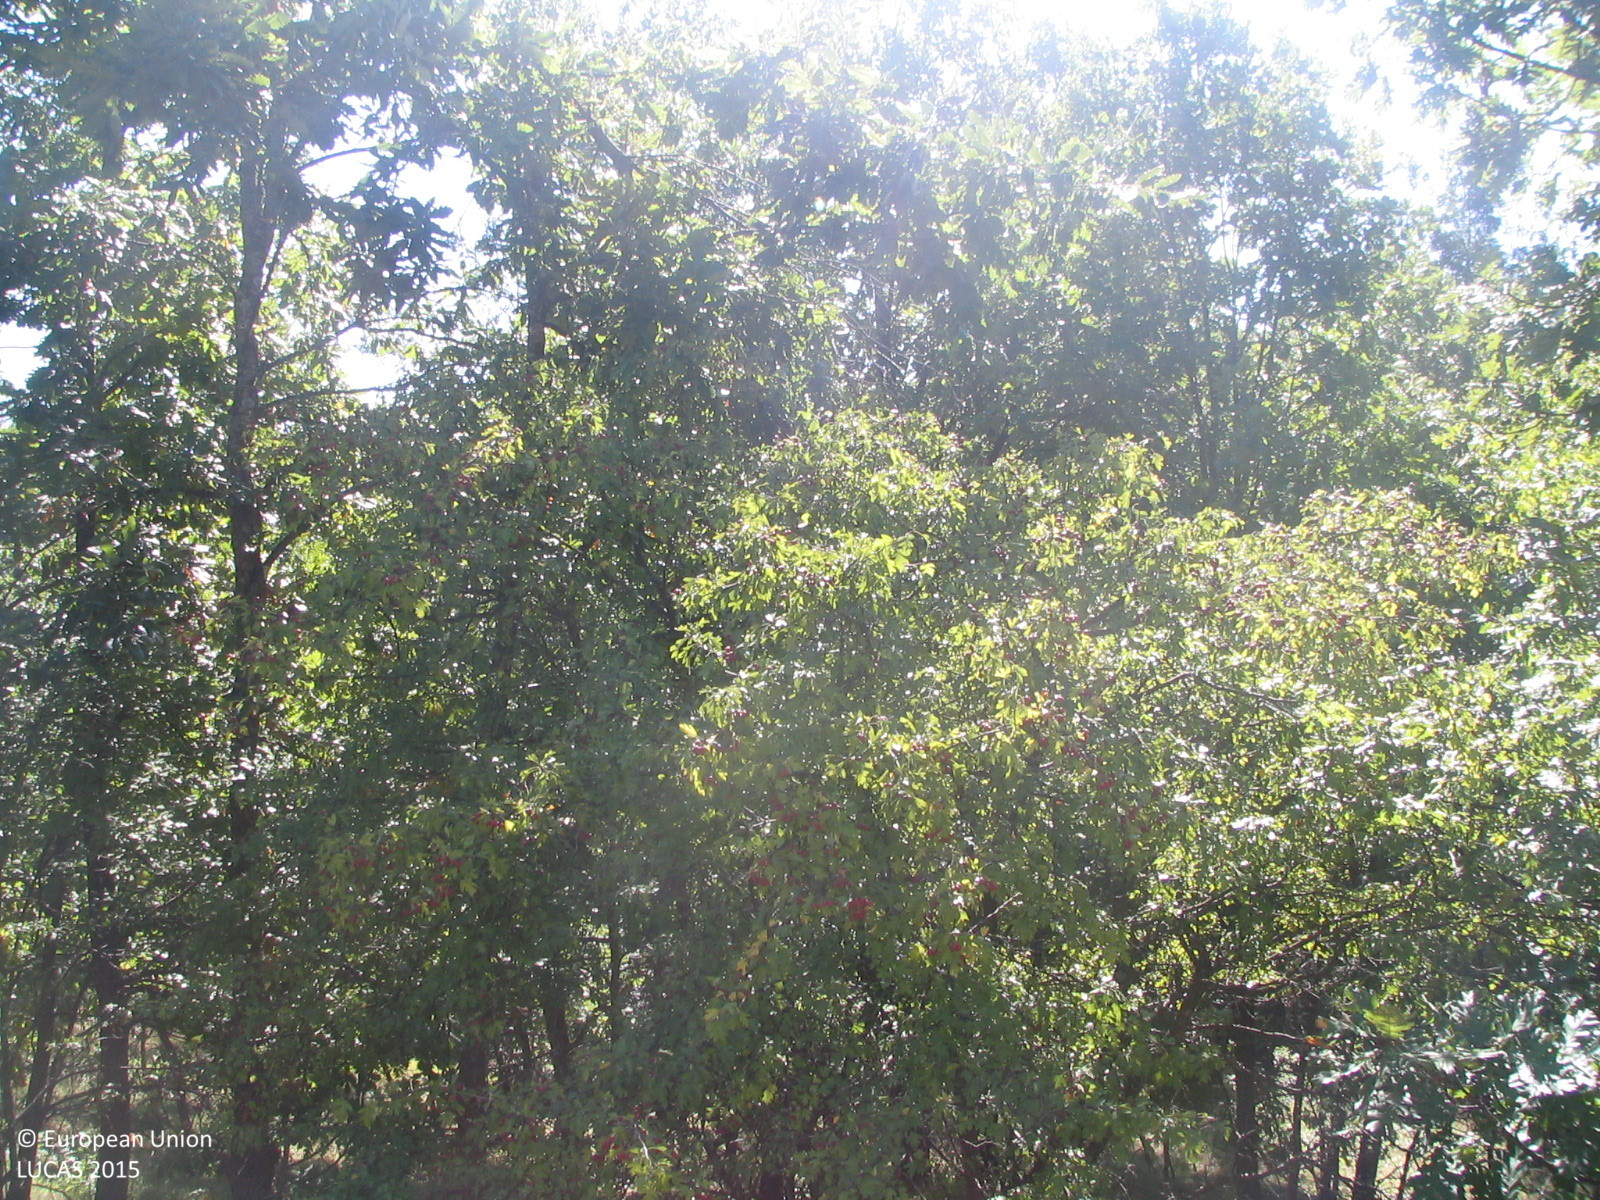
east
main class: Grassland
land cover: Grassland without tree/shrub cover
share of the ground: > 75 %
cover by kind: herbaceous plants 100 %
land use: Agriculture (excluding fallow land and kitchen gardens)
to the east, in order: Grassland without tree/shrub cover; Broadleaved woodland; Rivers and streams; Broadleaved woodland
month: September
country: BG
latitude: 42.9898
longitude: 24.4169
